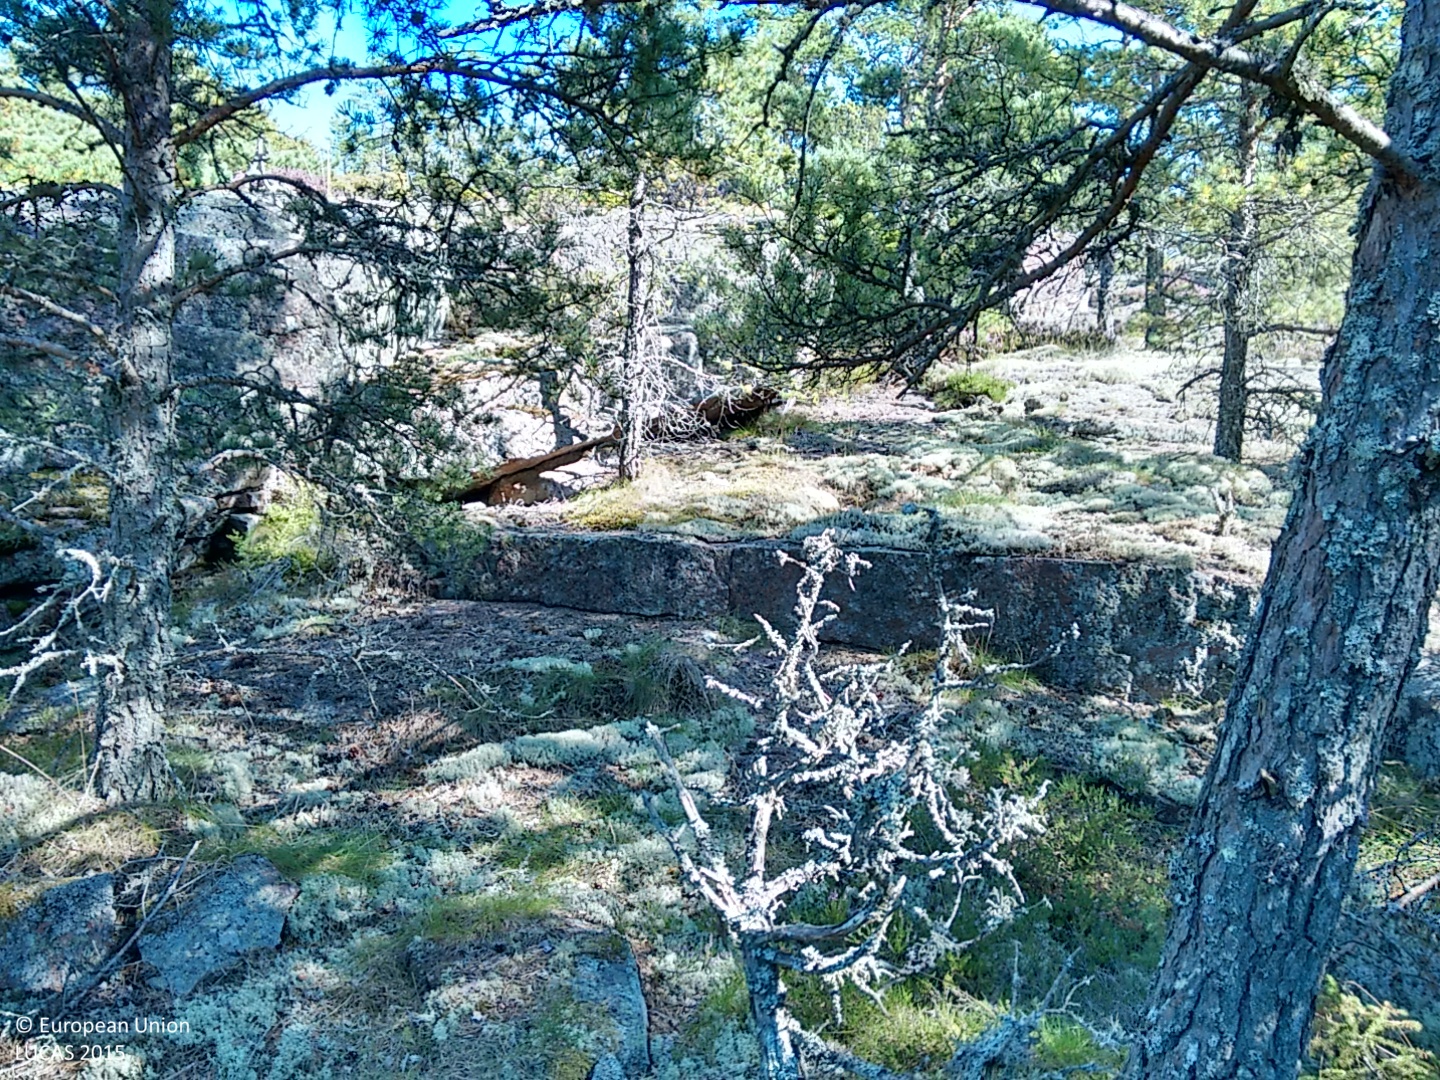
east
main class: Woodland
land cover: Pine dominated coniferous woodland
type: hemiboreal forest and nemoral coniferous forest and mixed broadleaved-coniferous forest
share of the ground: > 75 %
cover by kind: coniferous forest trees 80 %, lichens and mosses 10 %, shrubs 5 %, unconsolidated bare surface 5 %
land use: Forestry
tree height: > 5 m
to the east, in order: Pine dominated coniferous woodland
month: August
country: FI
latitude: 60.3698
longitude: 19.9970
